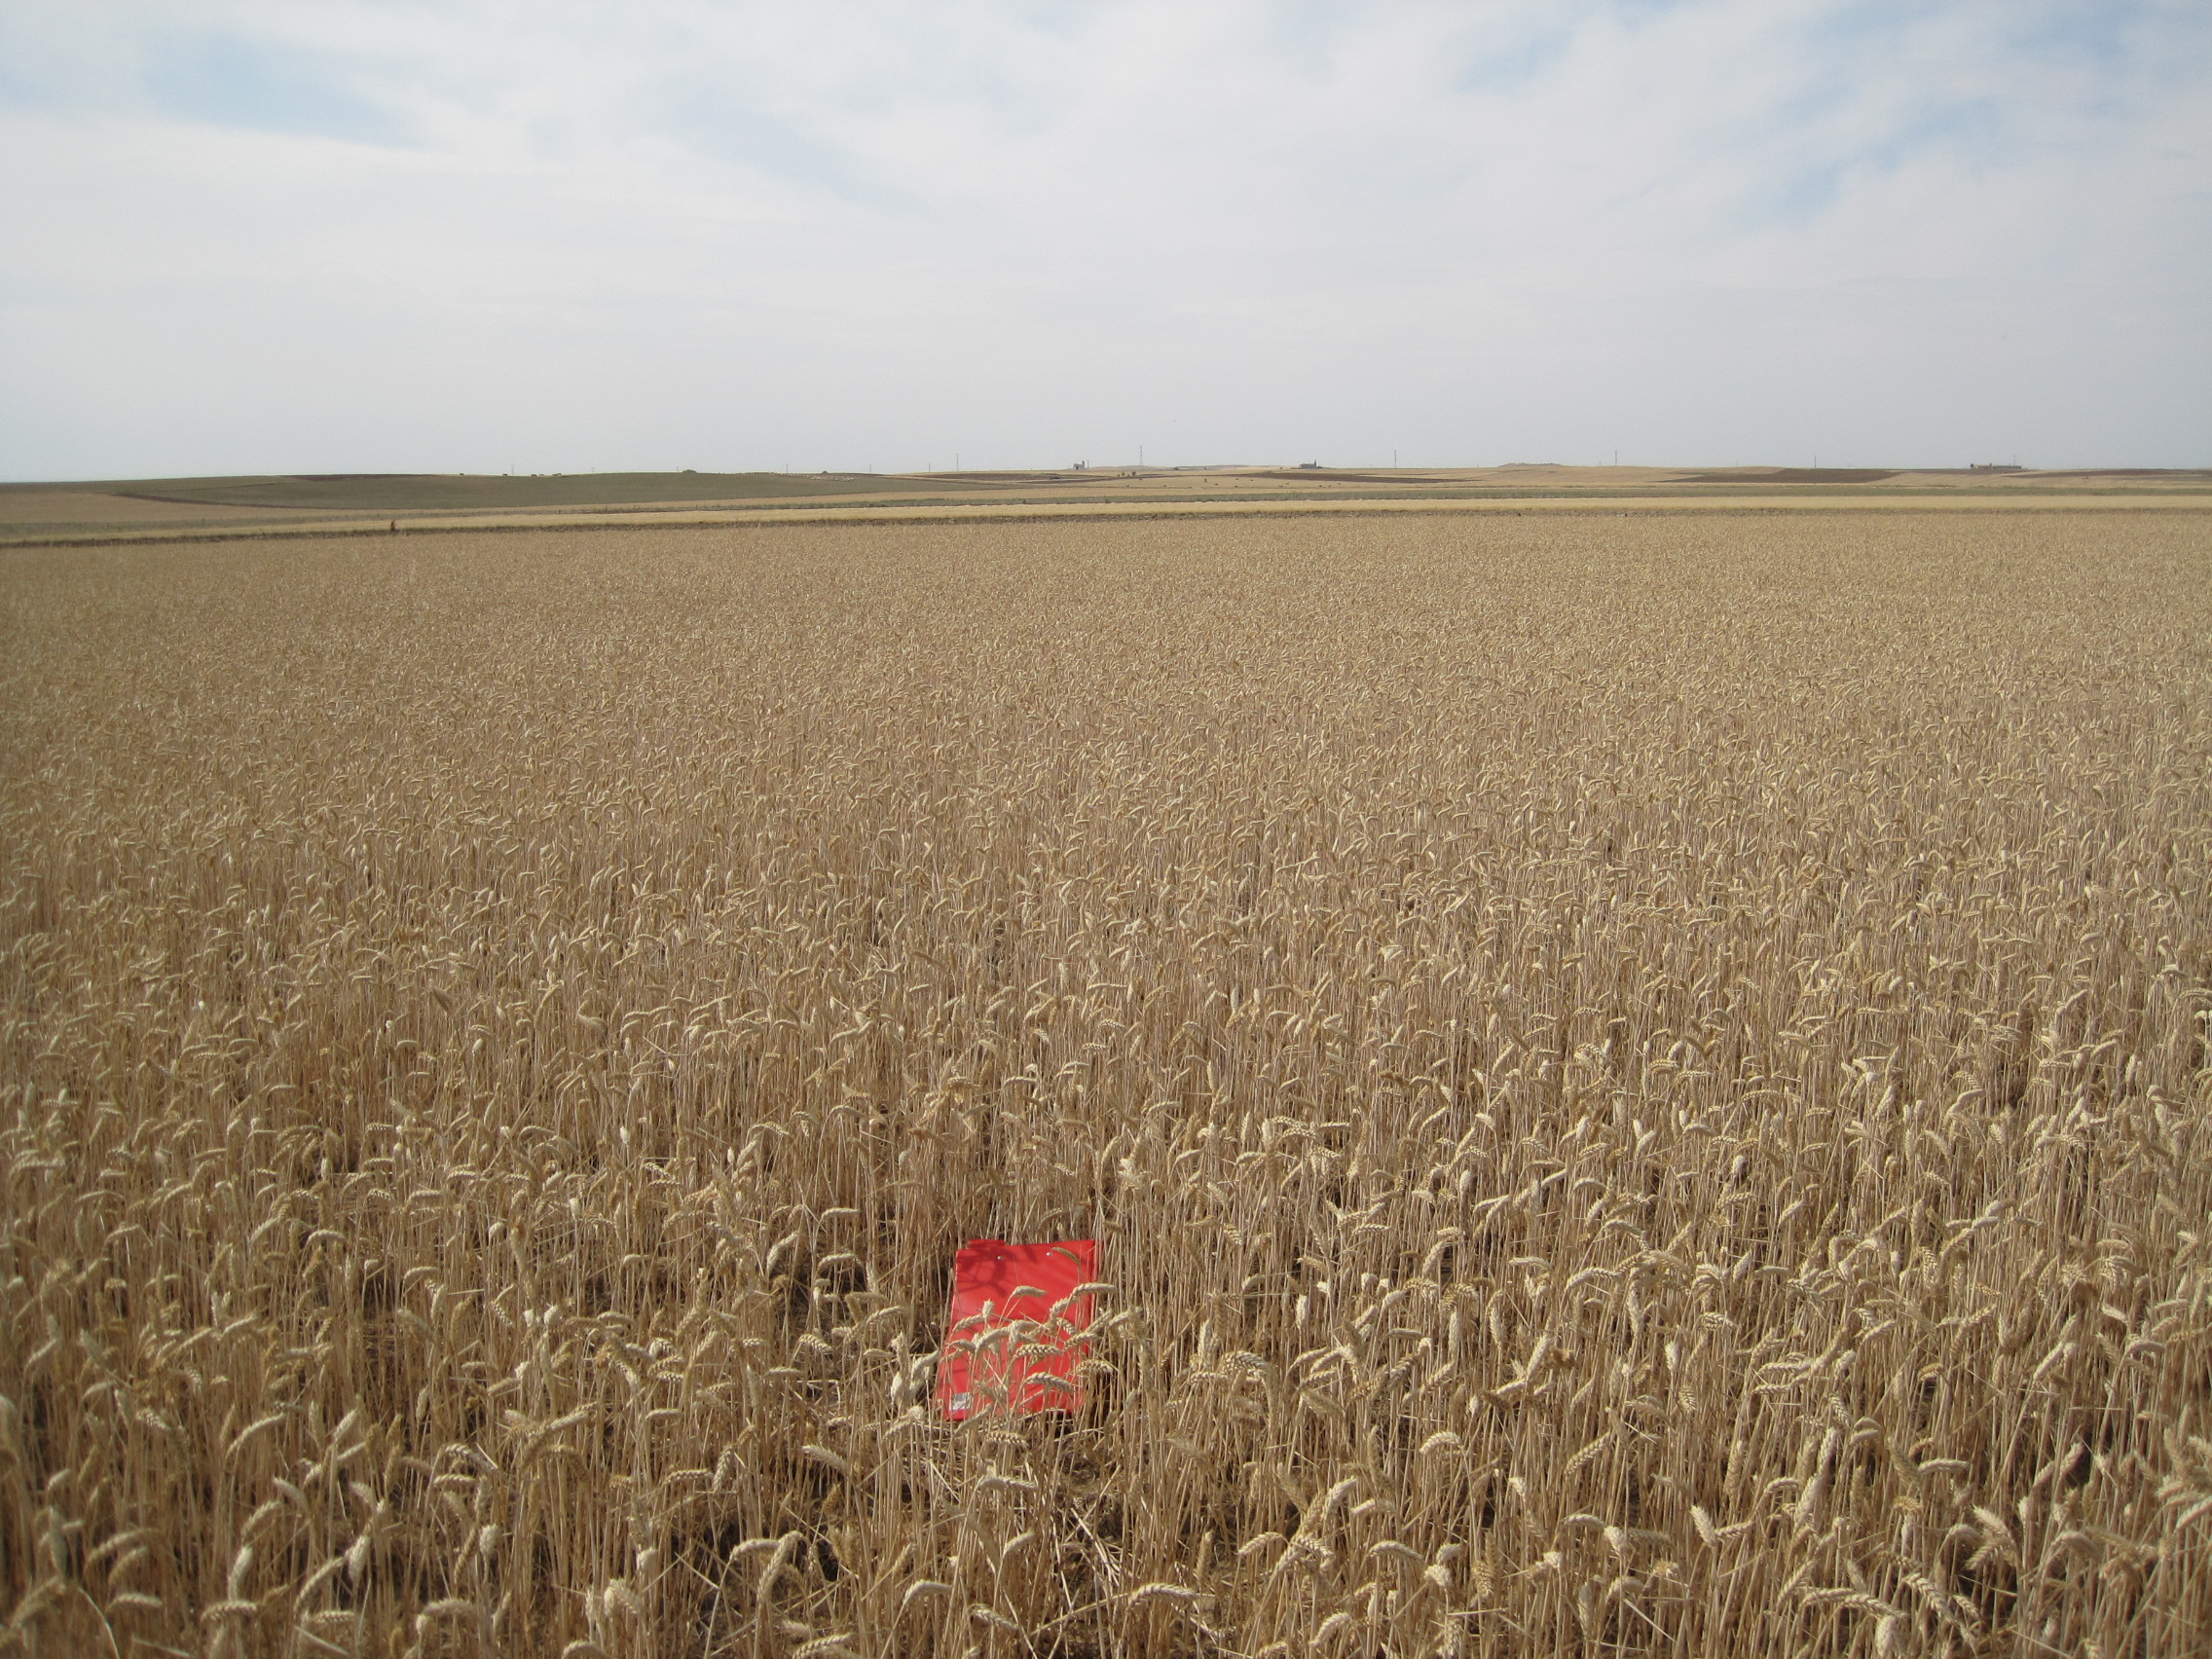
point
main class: Cropland
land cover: Common wheat
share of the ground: > 75 %
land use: Agriculture (excluding fallow land and kitchen gardens)
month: July
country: ES
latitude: 41.6949
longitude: -5.4756
